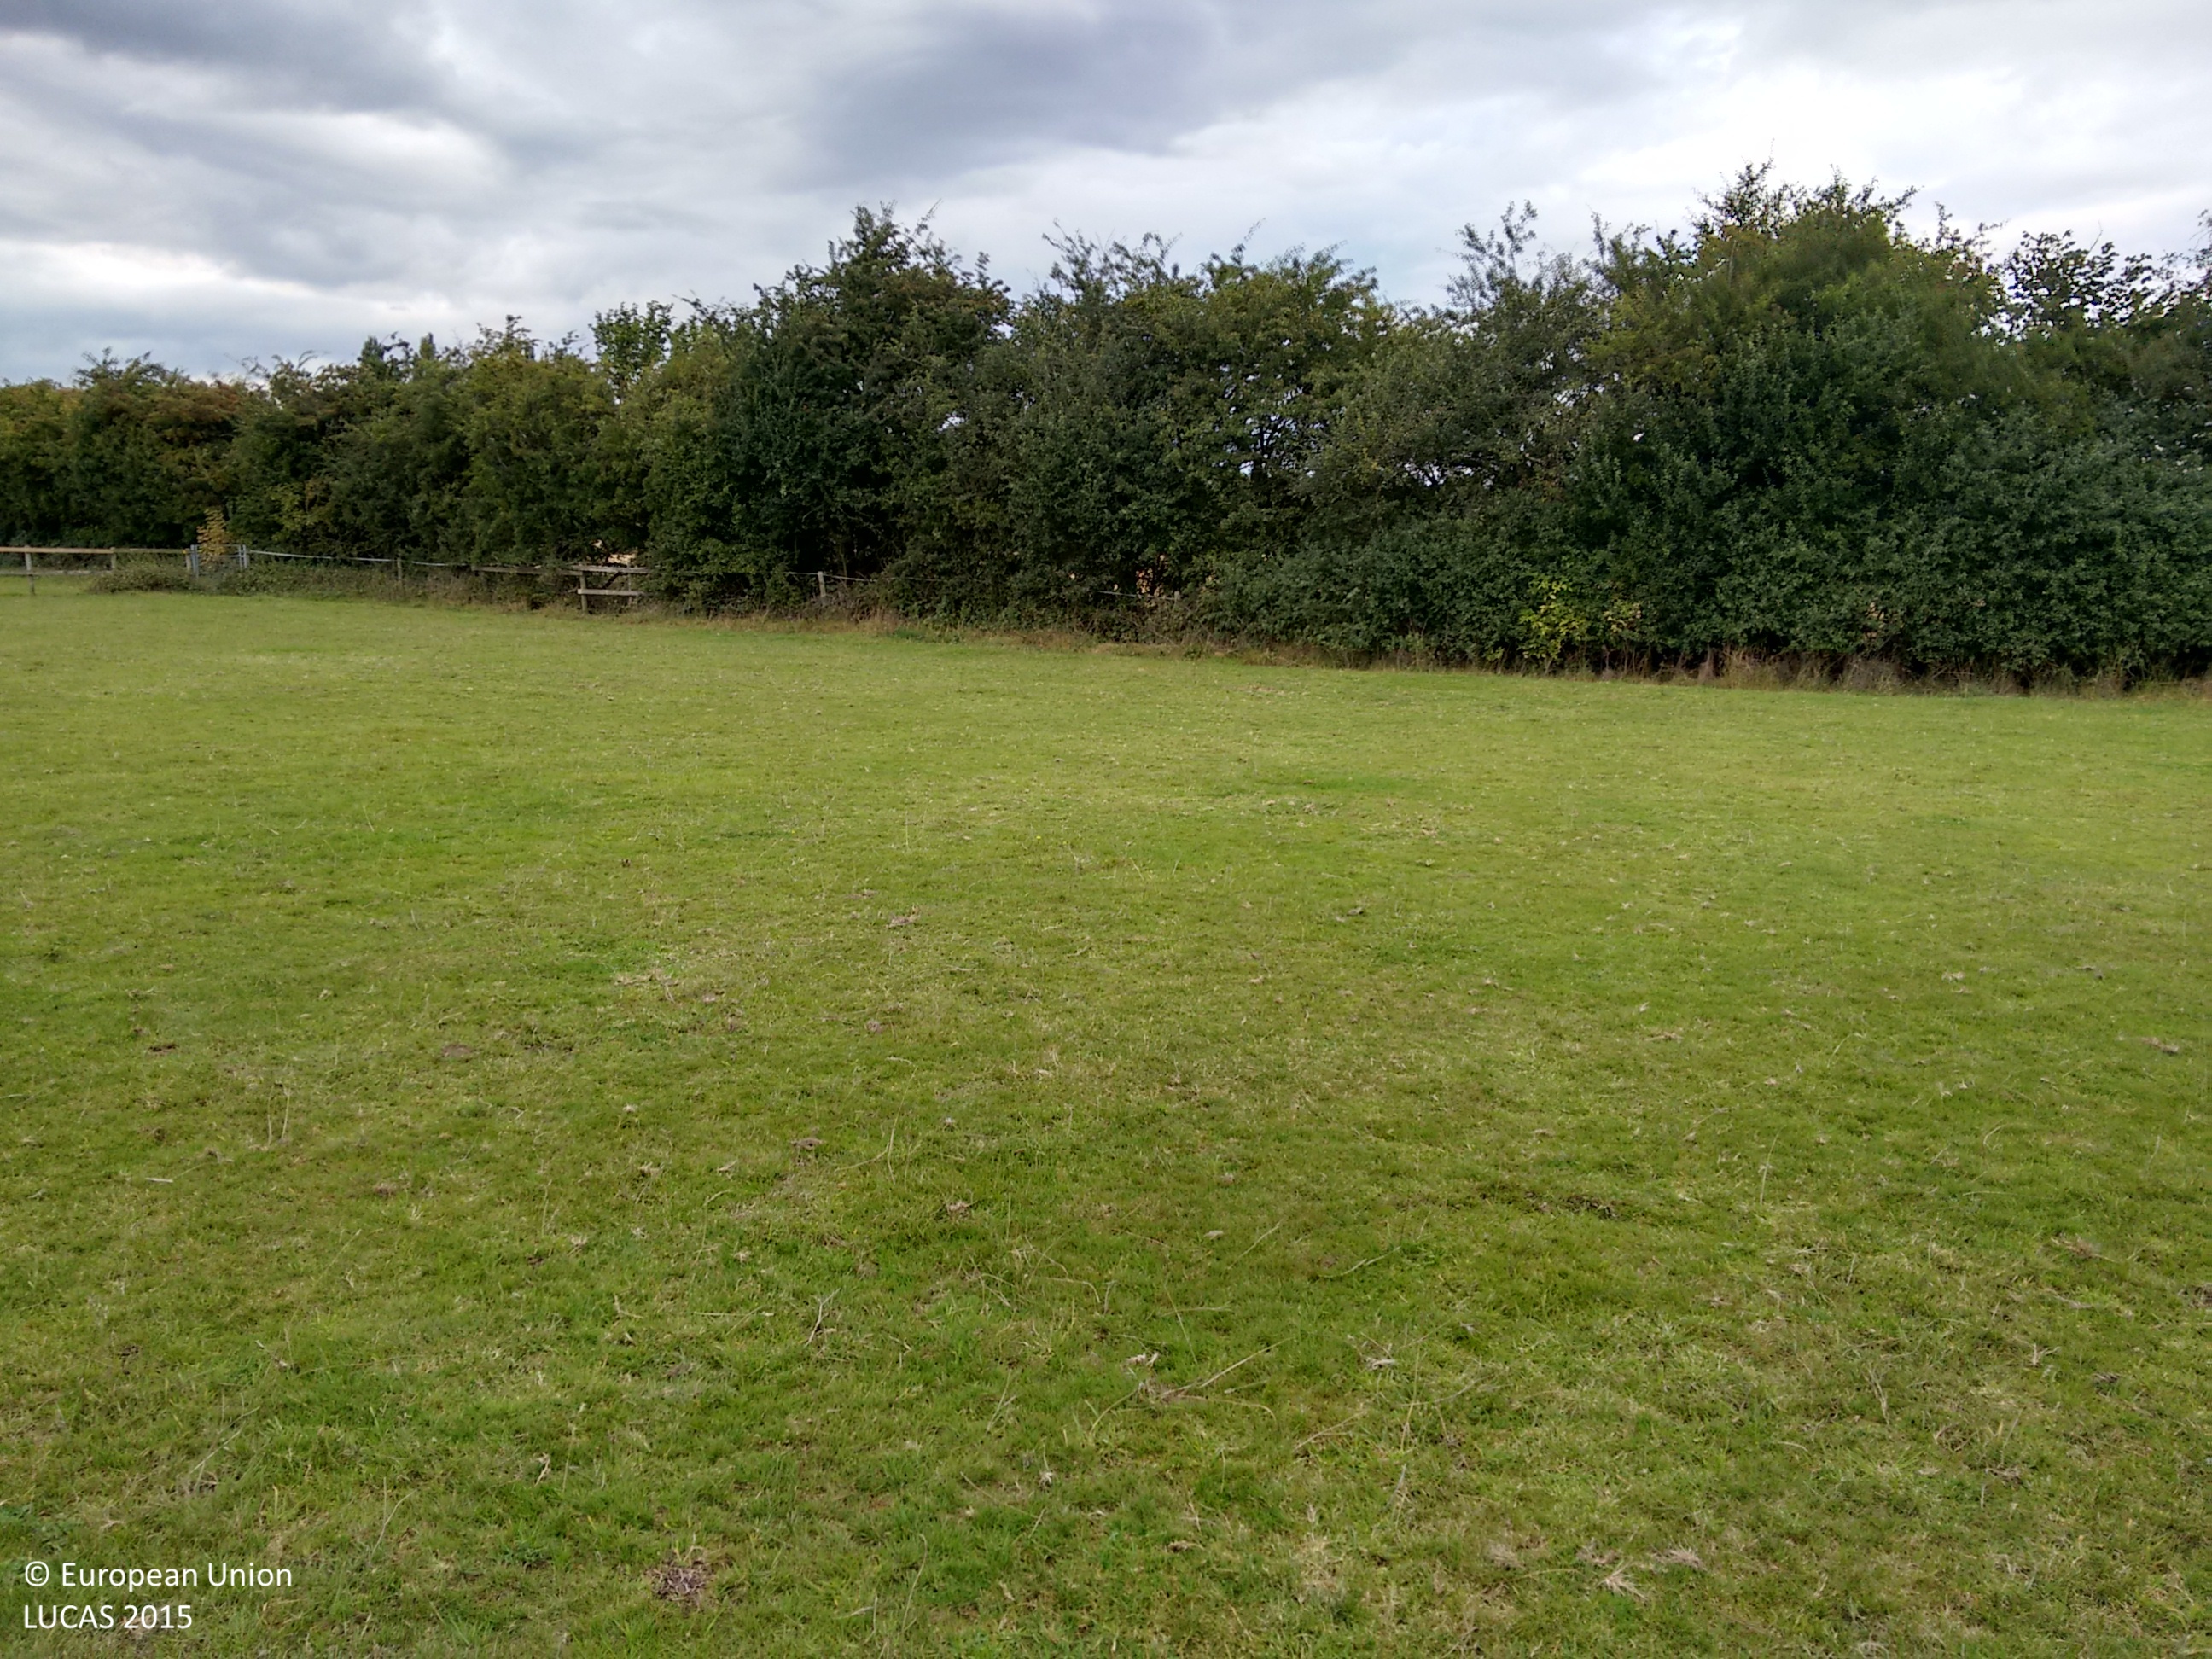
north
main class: Grassland
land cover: Grassland without tree/shrub cover
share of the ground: > 75 %
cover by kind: herbaceous plants 100 %
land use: Agriculture (excluding fallow land and kitchen gardens)
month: September
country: GB
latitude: 52.5592
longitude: -1.3328
